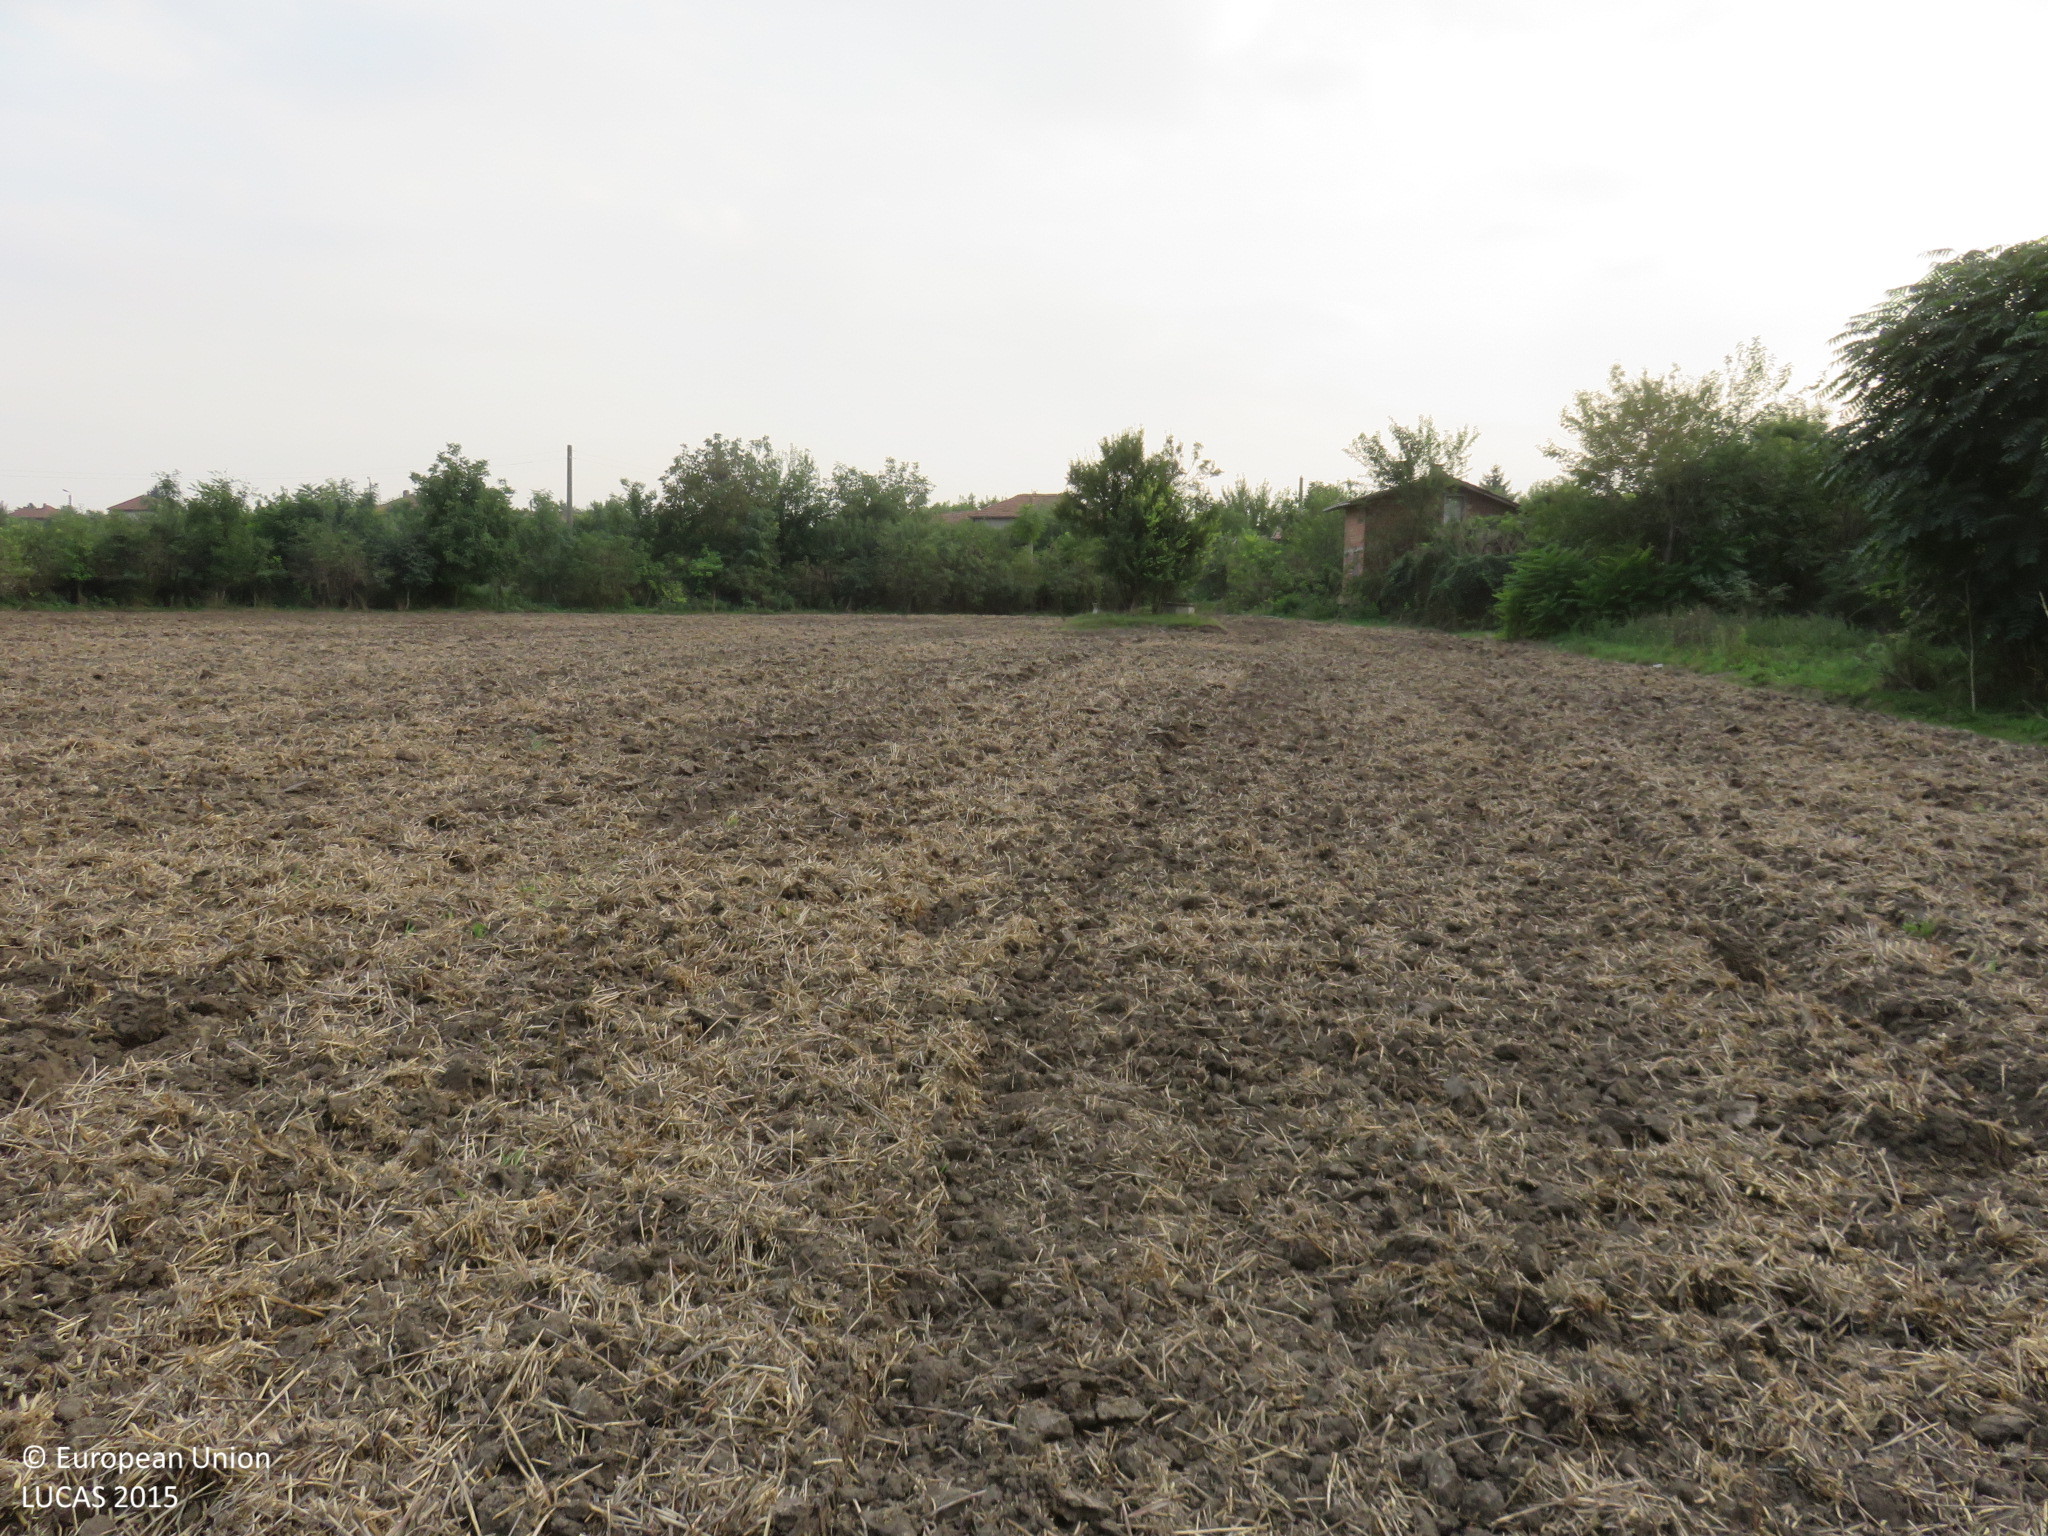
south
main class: Cropland
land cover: Common wheat
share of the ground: 10 - 25 %
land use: Agriculture (excluding fallow land and kitchen gardens)
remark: Harvested field
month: September
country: BG
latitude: 43.5553
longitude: 24.9374
